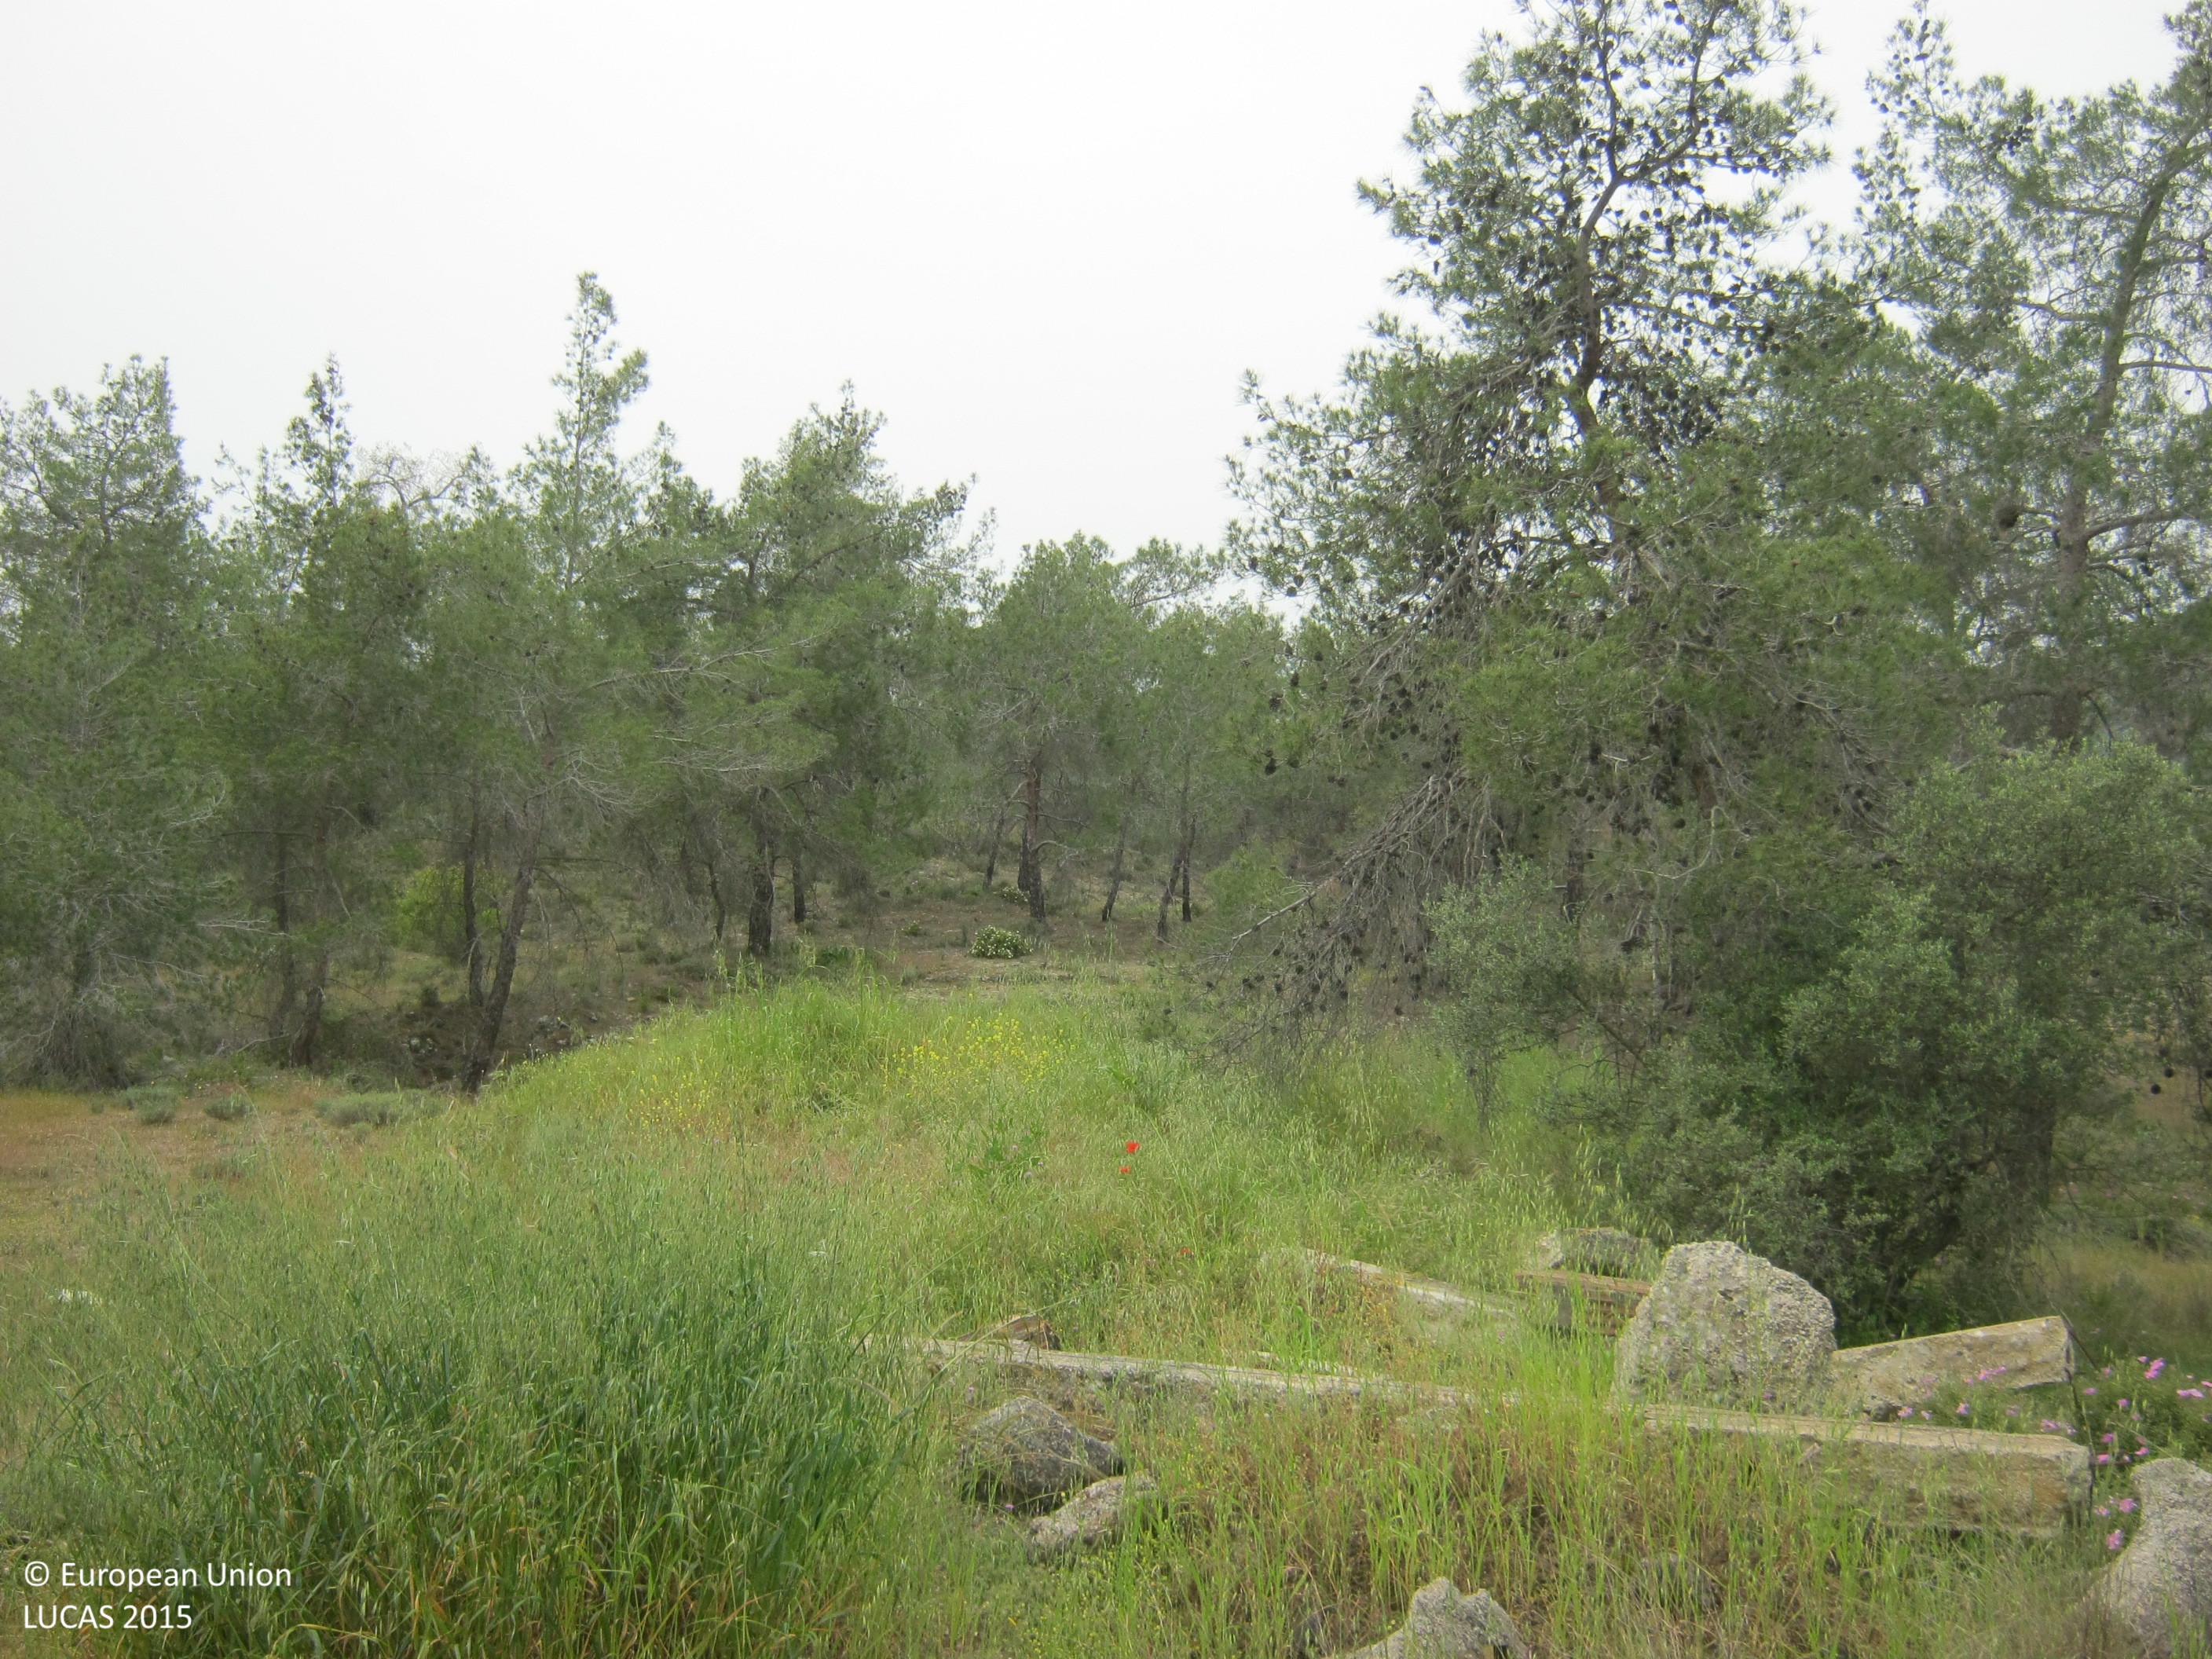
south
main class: Woodland
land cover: Pine dominated coniferous woodland
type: coniferous forest of the mediterranean region
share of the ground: 25 - 50 %
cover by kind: coniferous forest trees 40 %, herbaceous plants 30 %, shrubs 20 %, unconsolidated bare surface 10 %
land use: Semi-natural and natural areas not in use
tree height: > 5 m
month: April
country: CY
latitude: 34.9317
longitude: 33.3394
